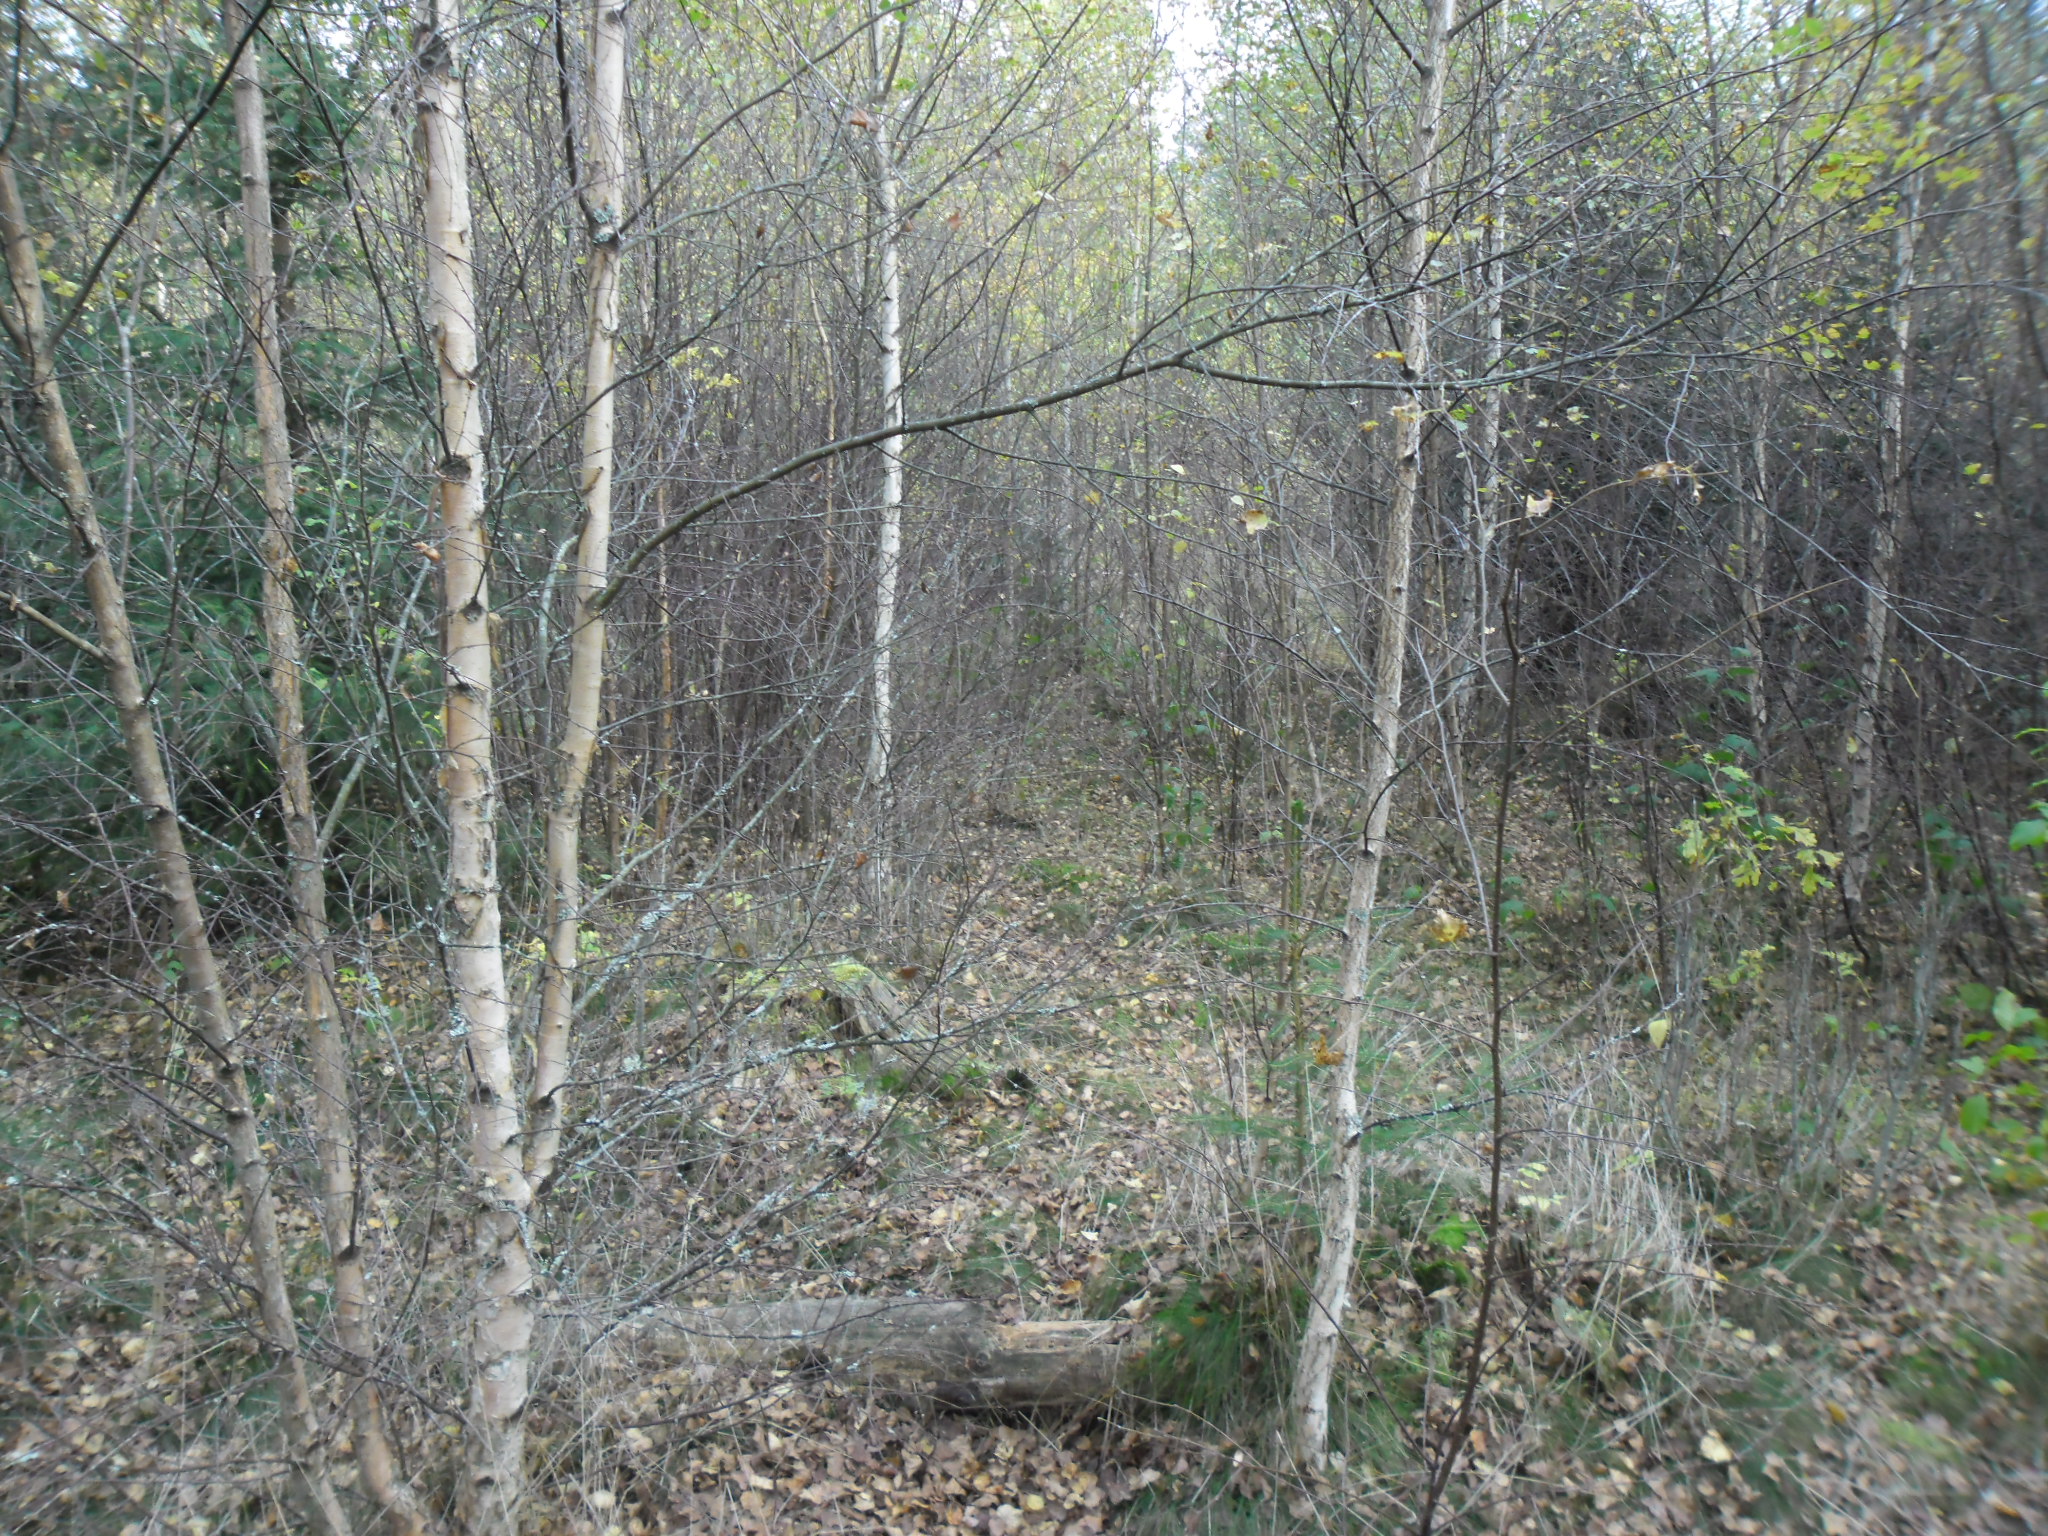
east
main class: Woodland
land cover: Spruce dominated mixed woodland
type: boreal forest
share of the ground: > 75 %
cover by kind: coniferous forest trees 60 %, broadleaved forest trees 30 %, herbaceous plants 10 %
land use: Forestry
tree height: < 5 m
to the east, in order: Spruce dominated mixed woodland; Broadleaved woodland; Dry stone walls; Broadleaved woodland; Dry stone walls; Grassland without tree/shrub cover; Fences; Ditches and canals; Abandoned hedges; Fences; Grassland without tree/shrub cover
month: October
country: SE
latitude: 56.2947
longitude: 13.7621
